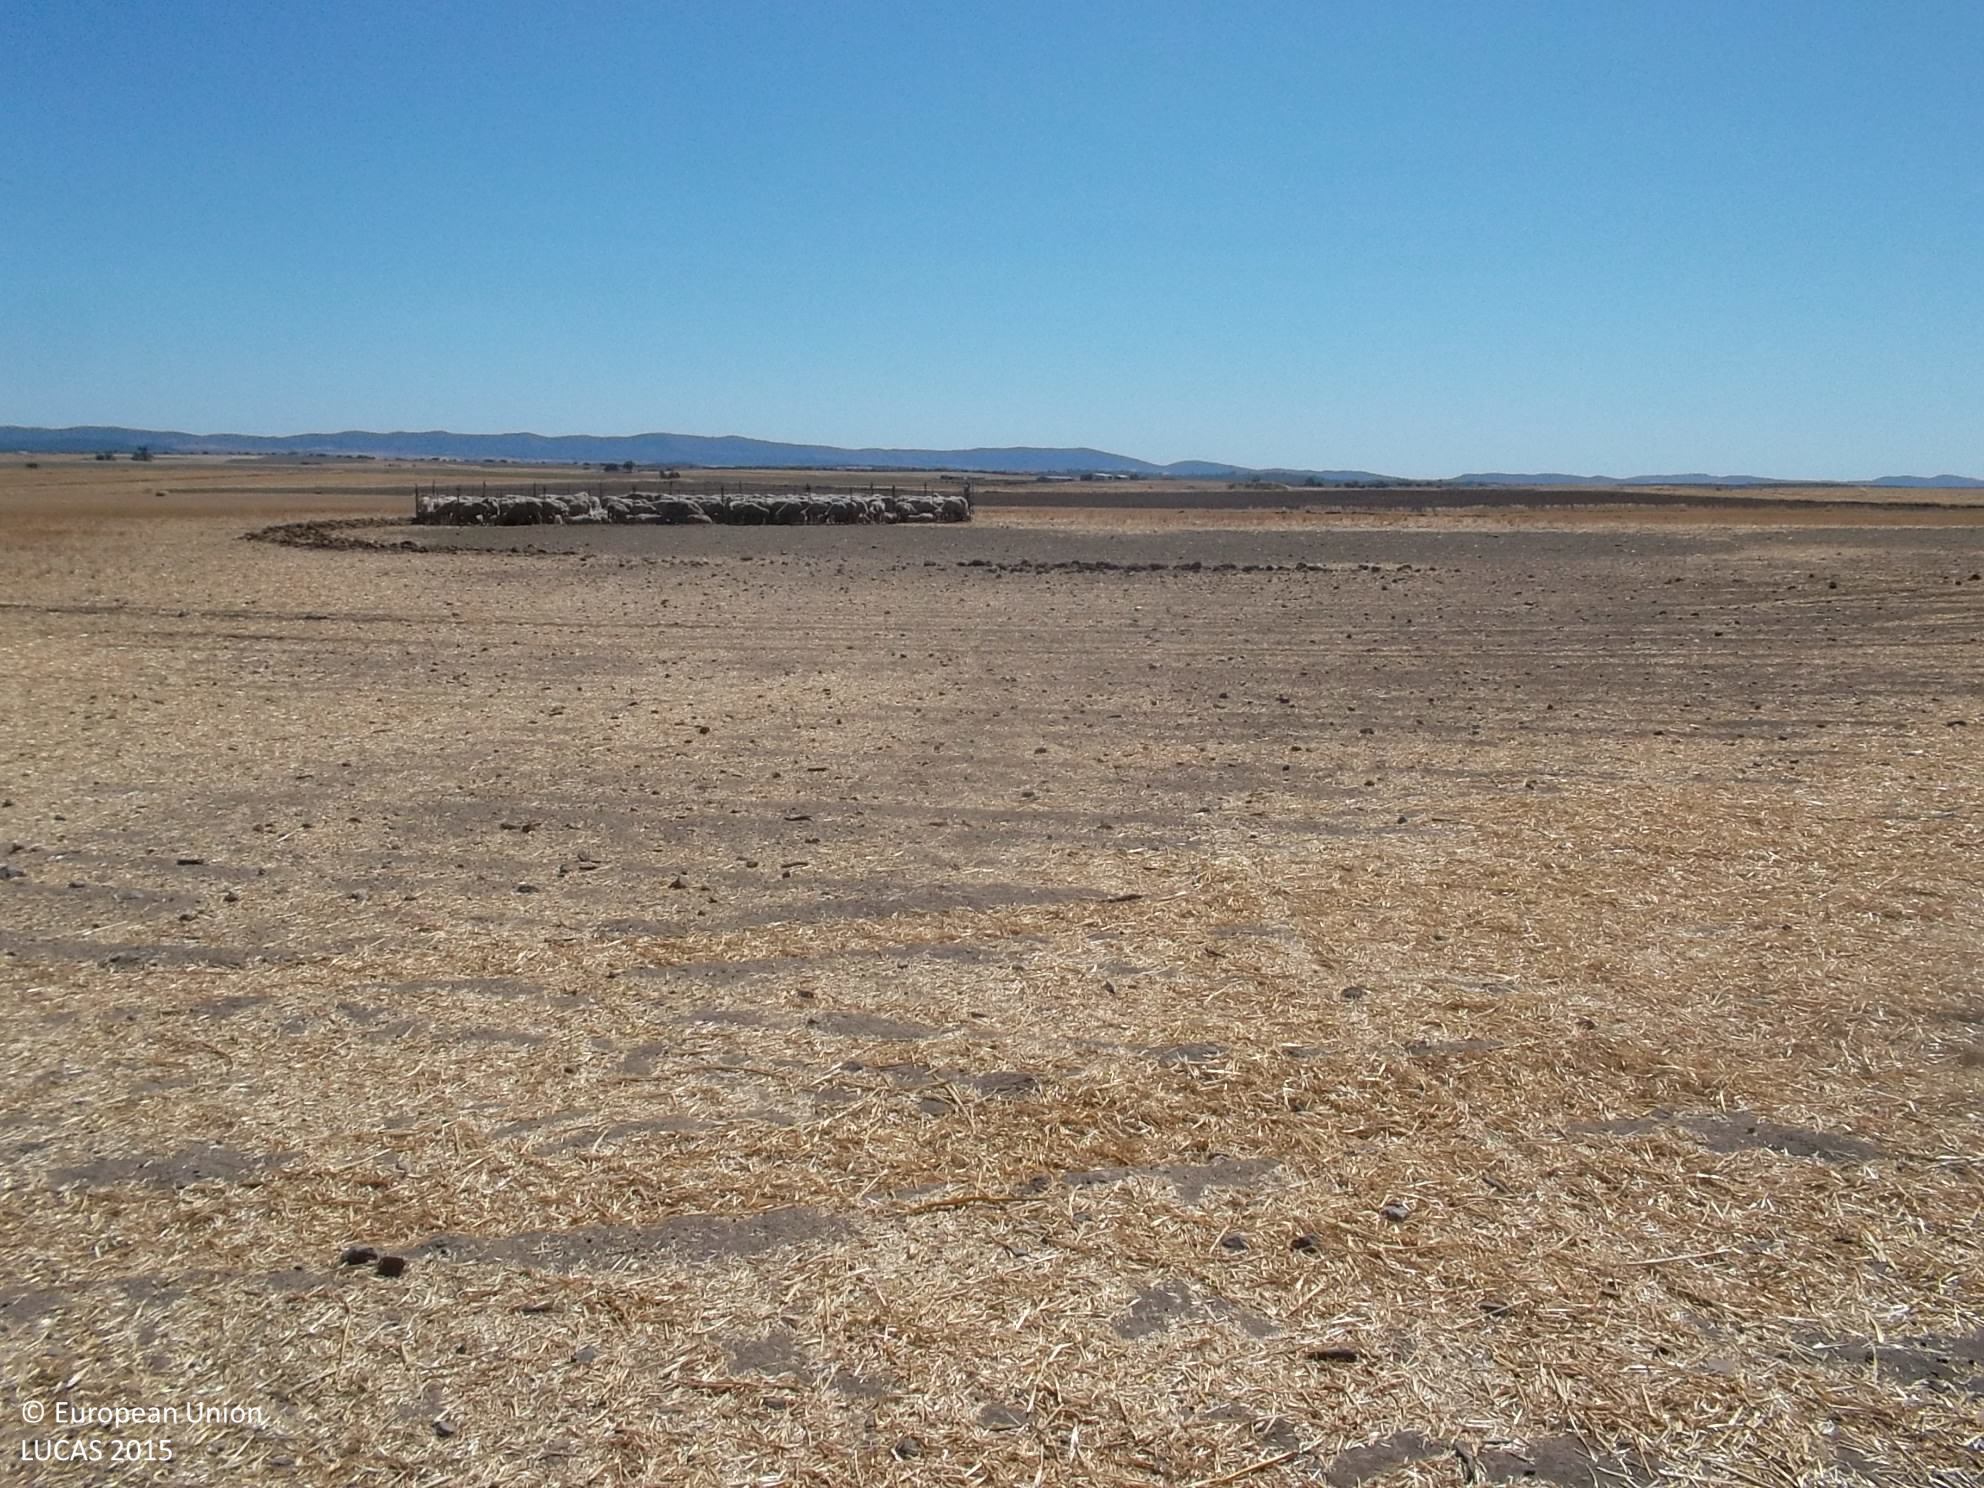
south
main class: Cropland
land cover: Oats
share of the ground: < 10 %
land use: Agriculture (excluding fallow land and kitchen gardens)
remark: Harvested field
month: July
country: ES
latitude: 38.2542
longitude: -5.7250
